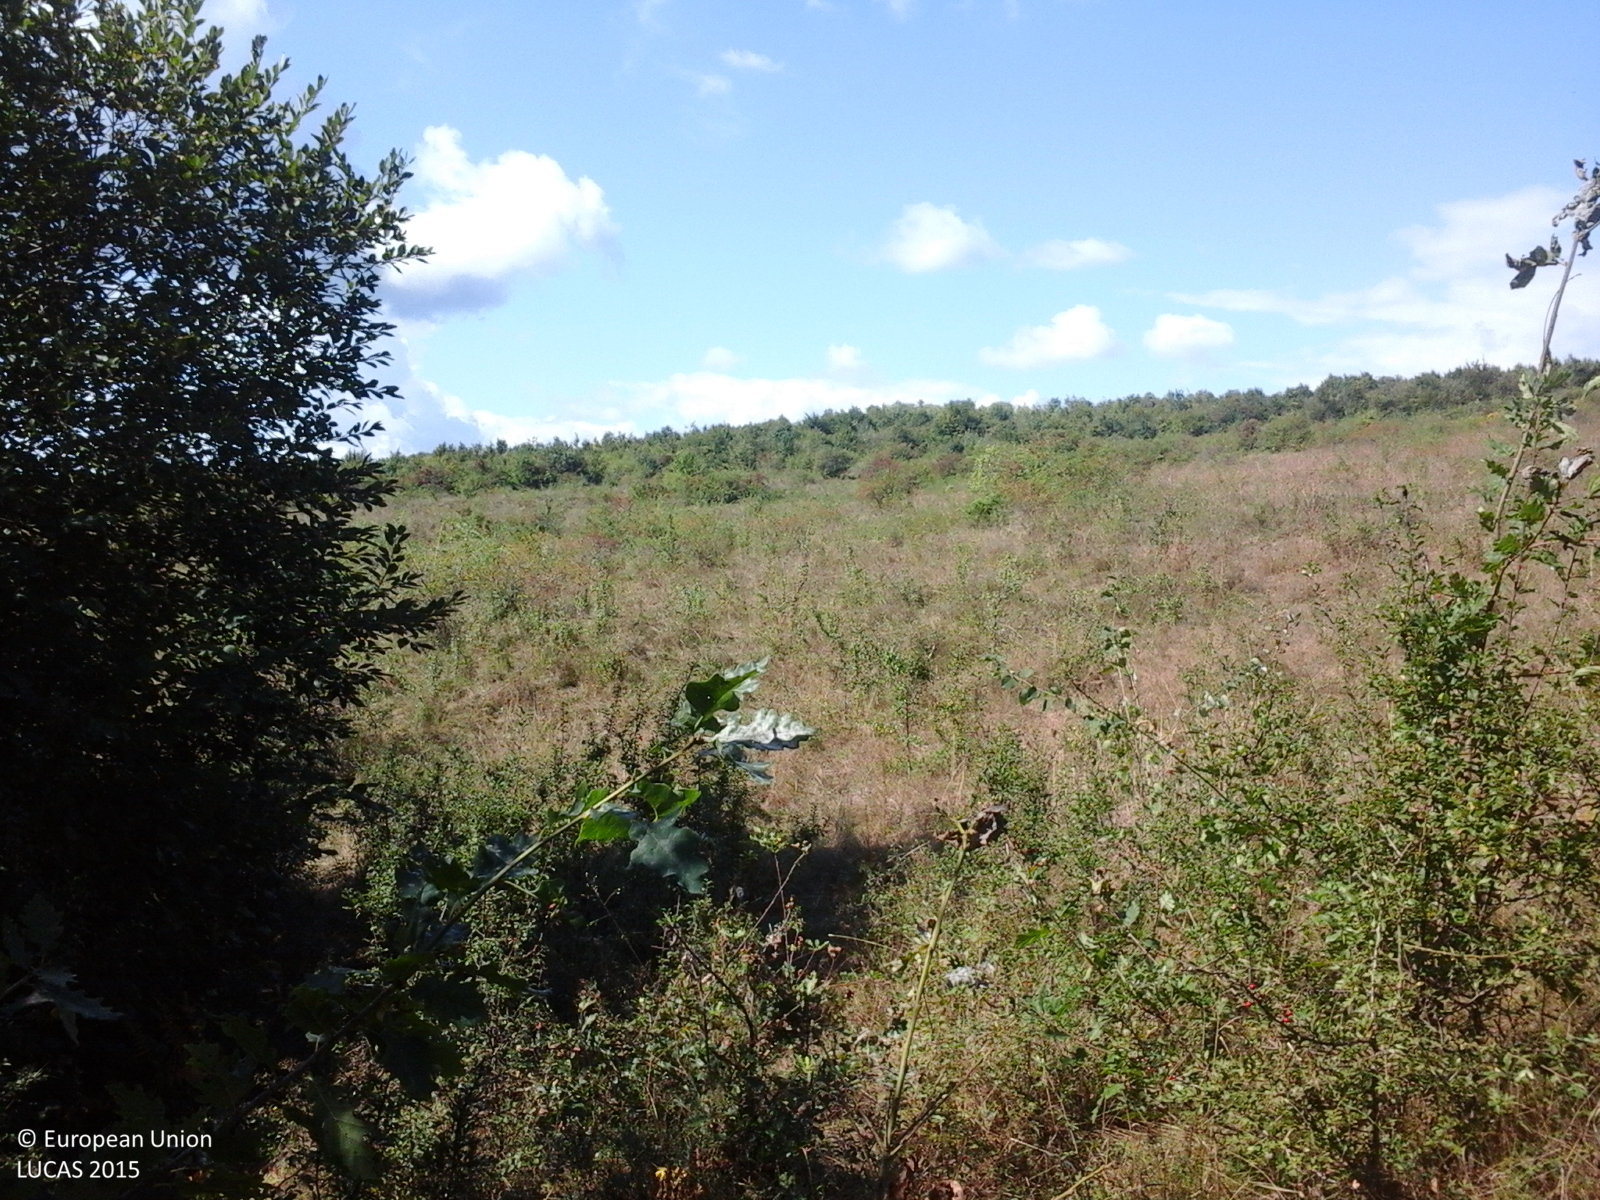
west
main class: Woodland
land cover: Broadleaved woodland
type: beech forest
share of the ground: > 75 %
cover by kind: broadleaved forest trees 100 %
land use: Forestry
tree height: > 5 m
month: September
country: RO
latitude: 47.3717
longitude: 23.4881
